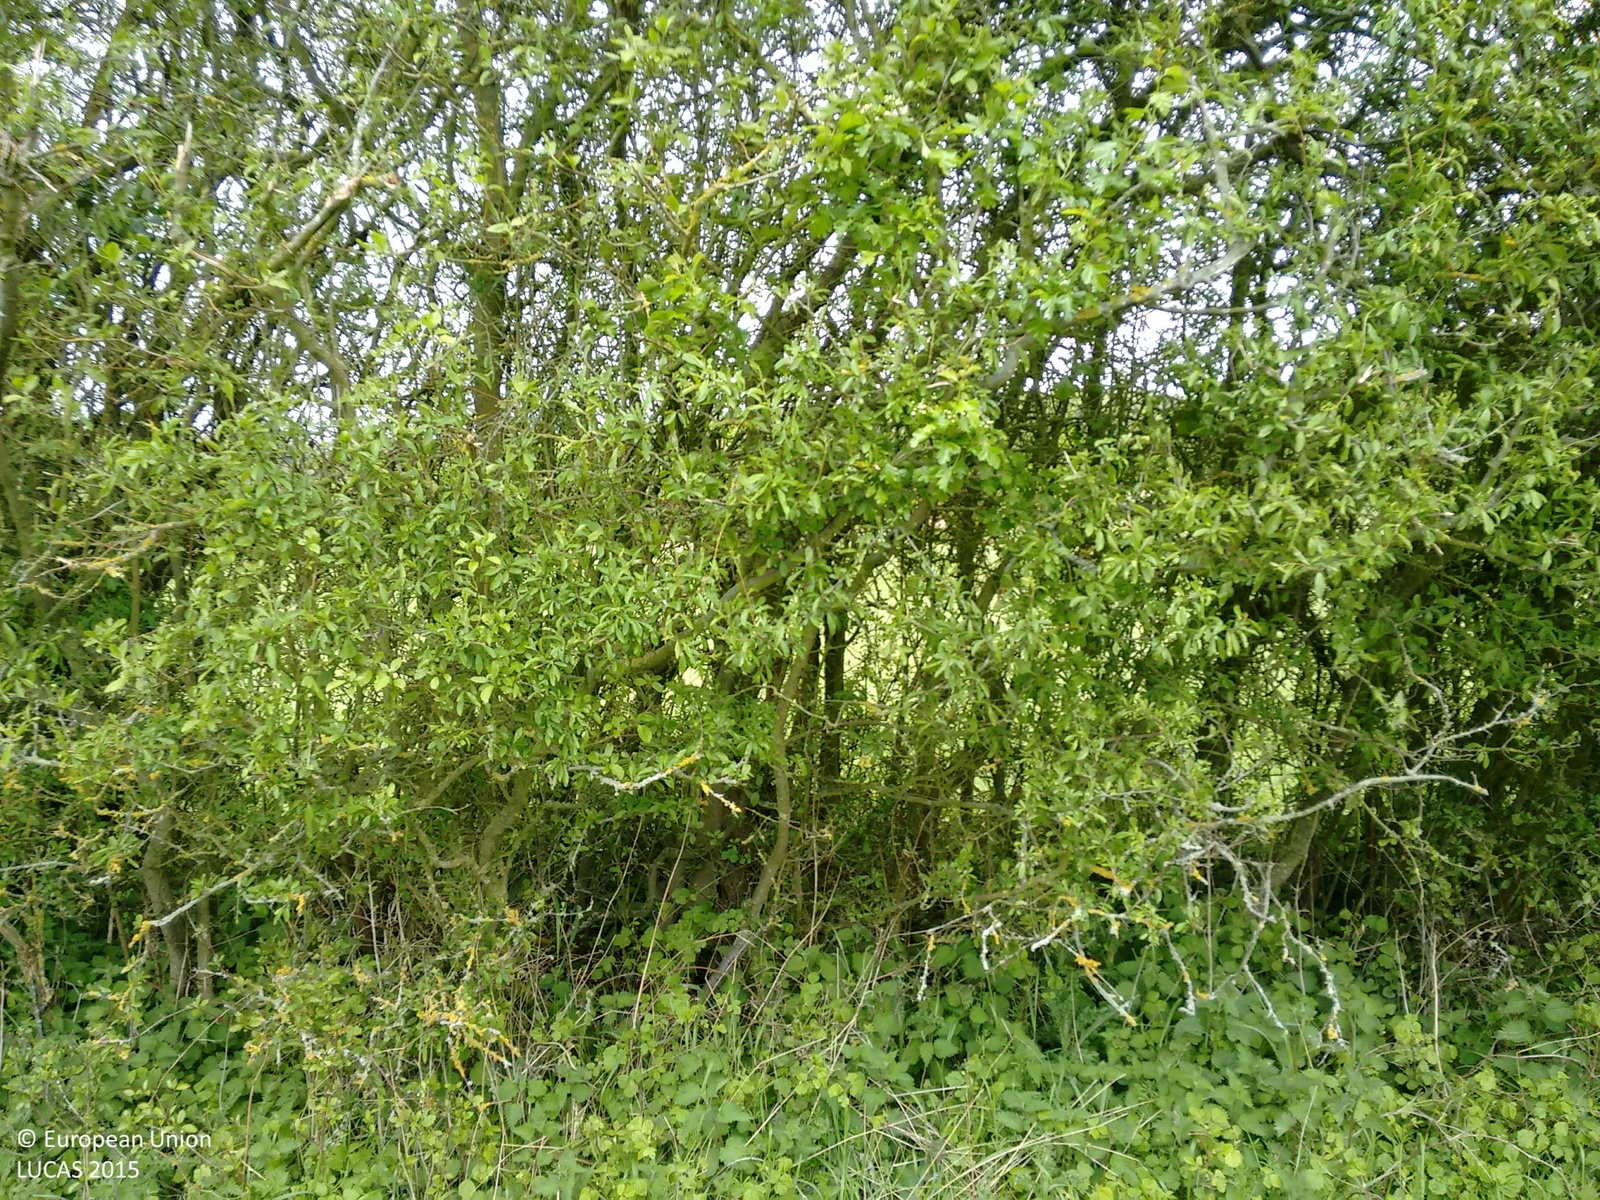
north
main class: Grassland
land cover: Grassland without tree/shrub cover
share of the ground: > 75 %
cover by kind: herbaceous plants 100 %
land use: Sport
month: May
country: GB
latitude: 51.8096
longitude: -0.6133
